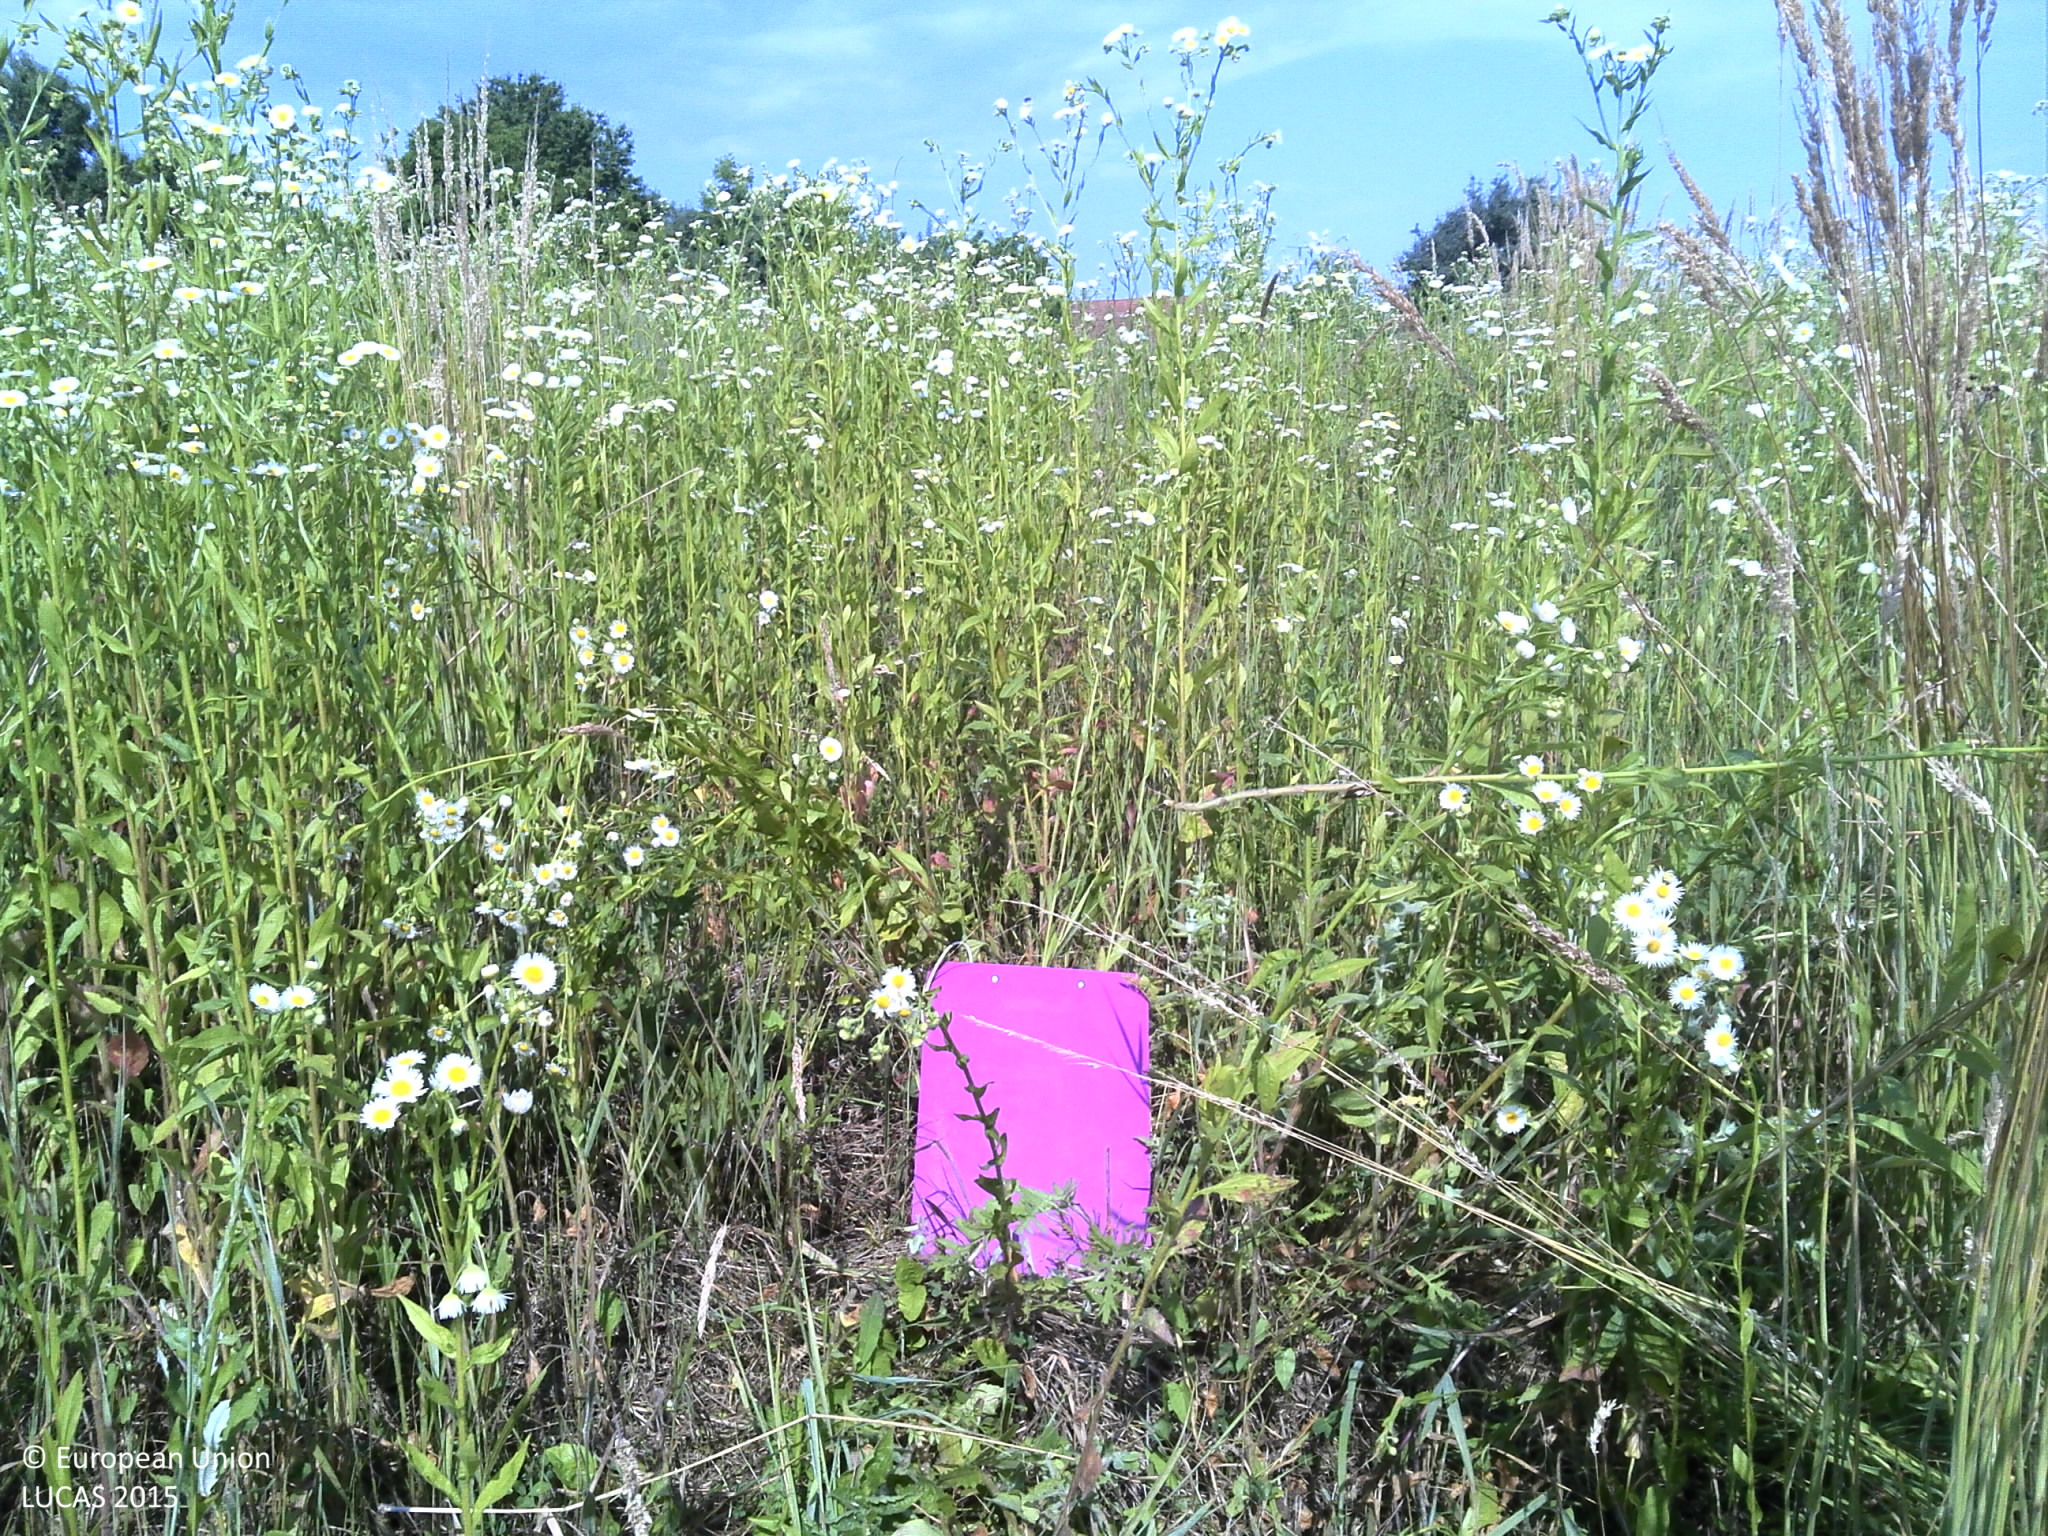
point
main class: Grassland
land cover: Spontaneously vegetated surfaces
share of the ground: > 75 %
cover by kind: herbaceous plants 100 %
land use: Semi-natural and natural areas not in use
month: June
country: HR
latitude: 45.4609
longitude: 17.1490
